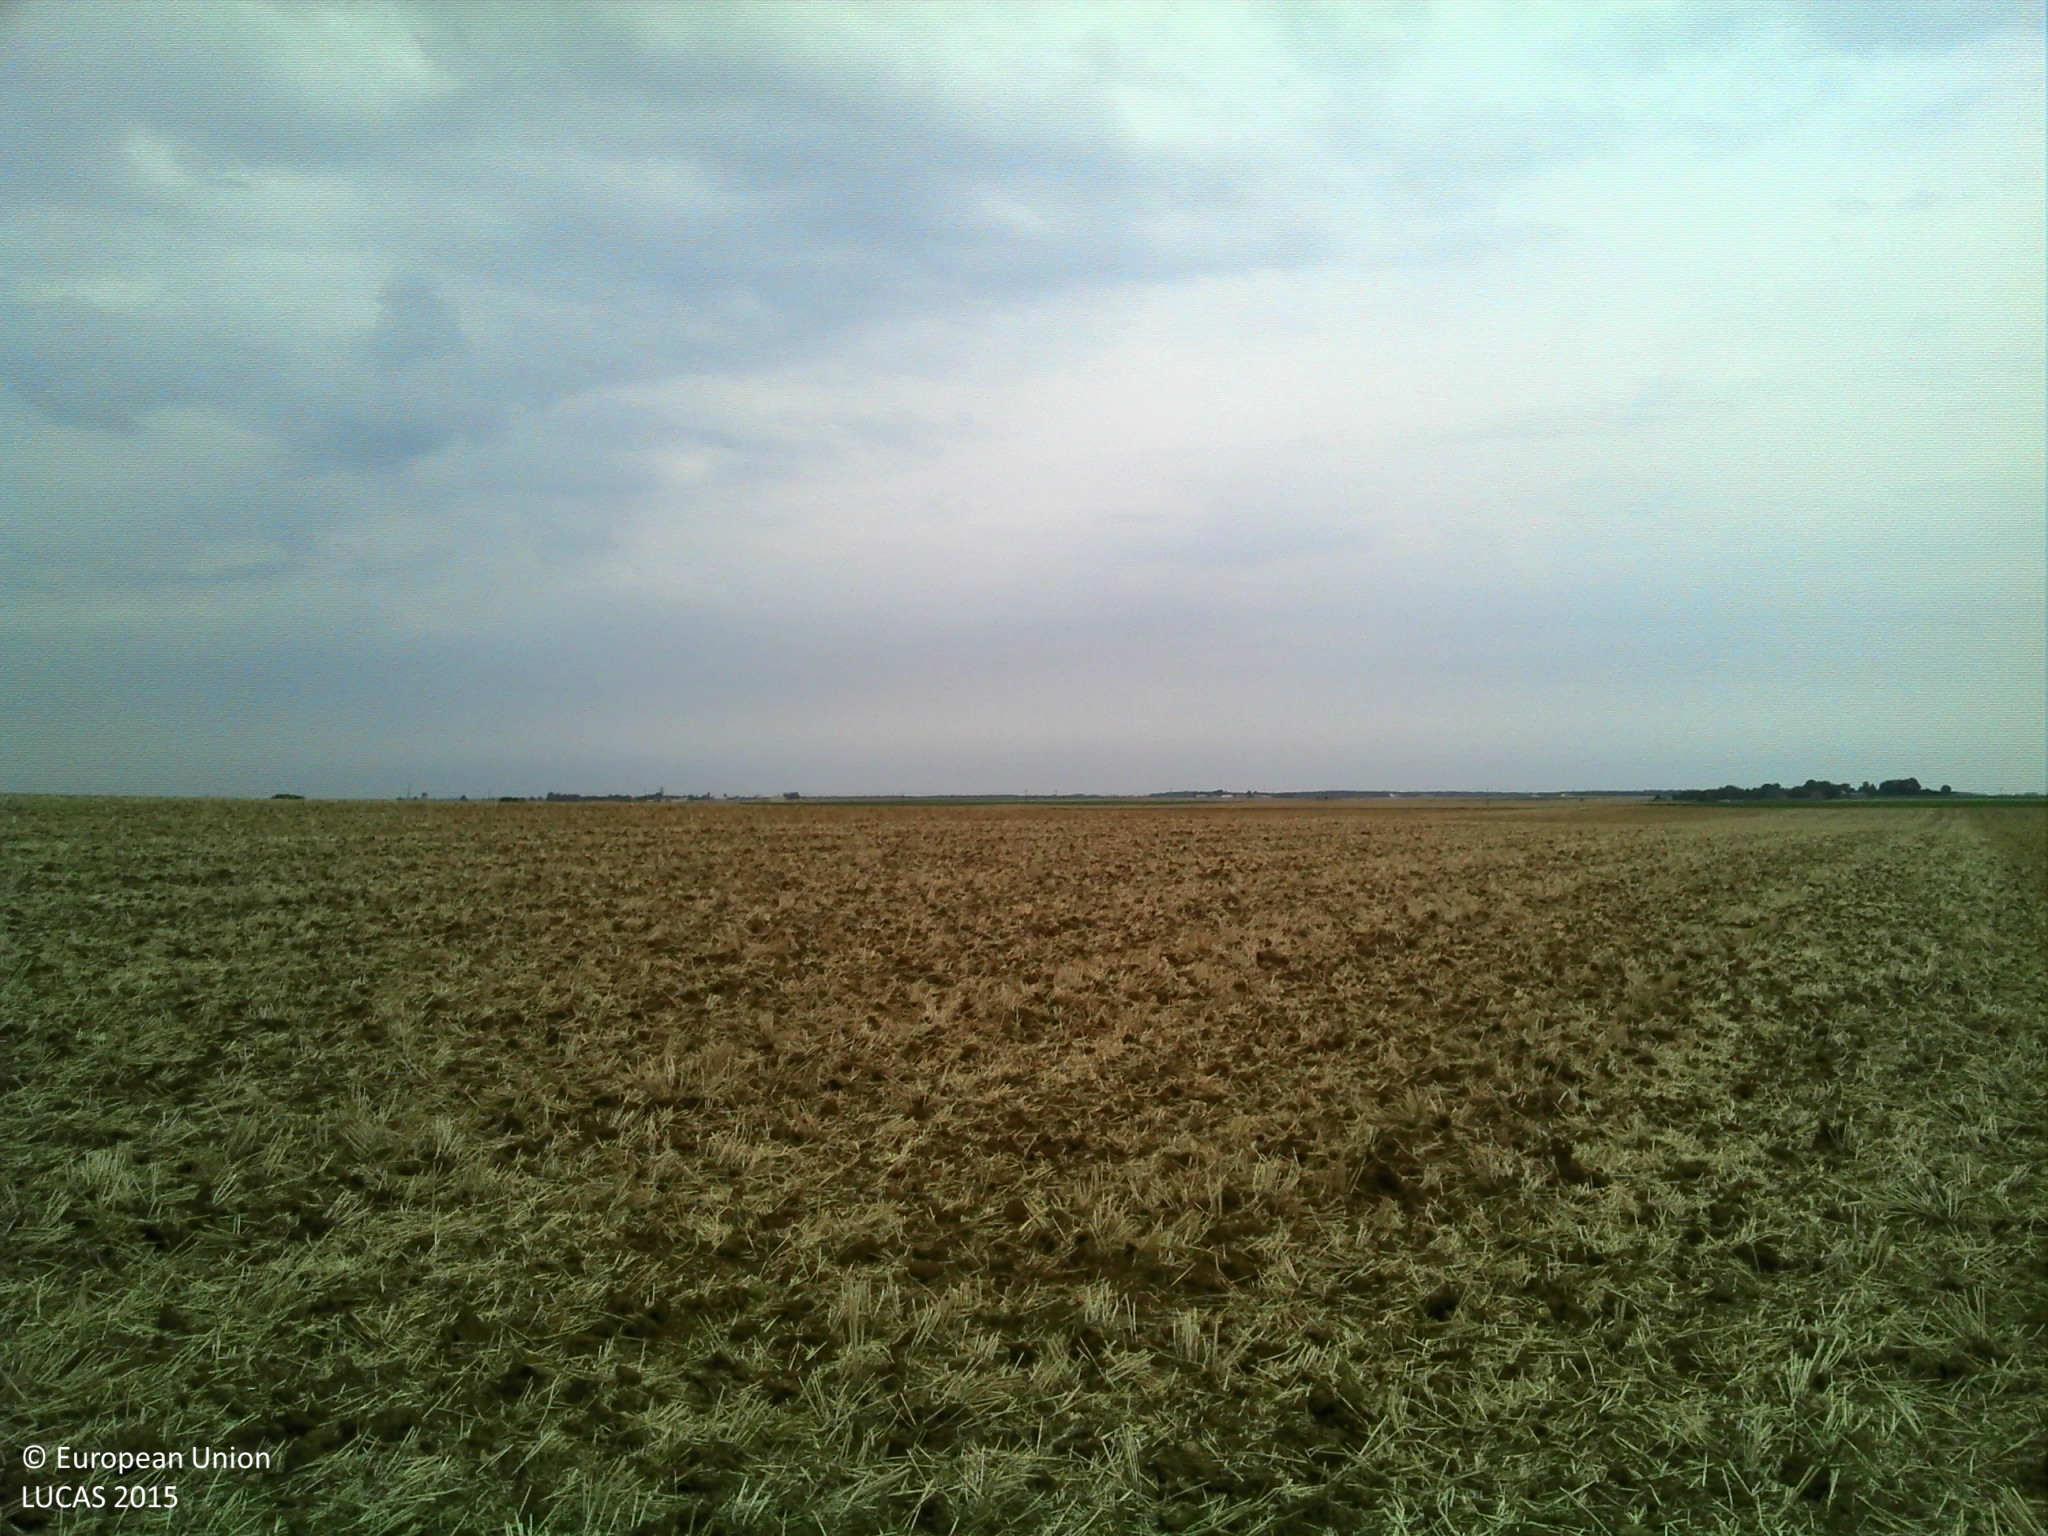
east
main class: Cropland
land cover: Common wheat
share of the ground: 25 - 50 %
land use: Agriculture (excluding fallow land and kitchen gardens)
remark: Harvested field
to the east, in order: Common wheat
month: August
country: FR
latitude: 48.2061
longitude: 2.5490
